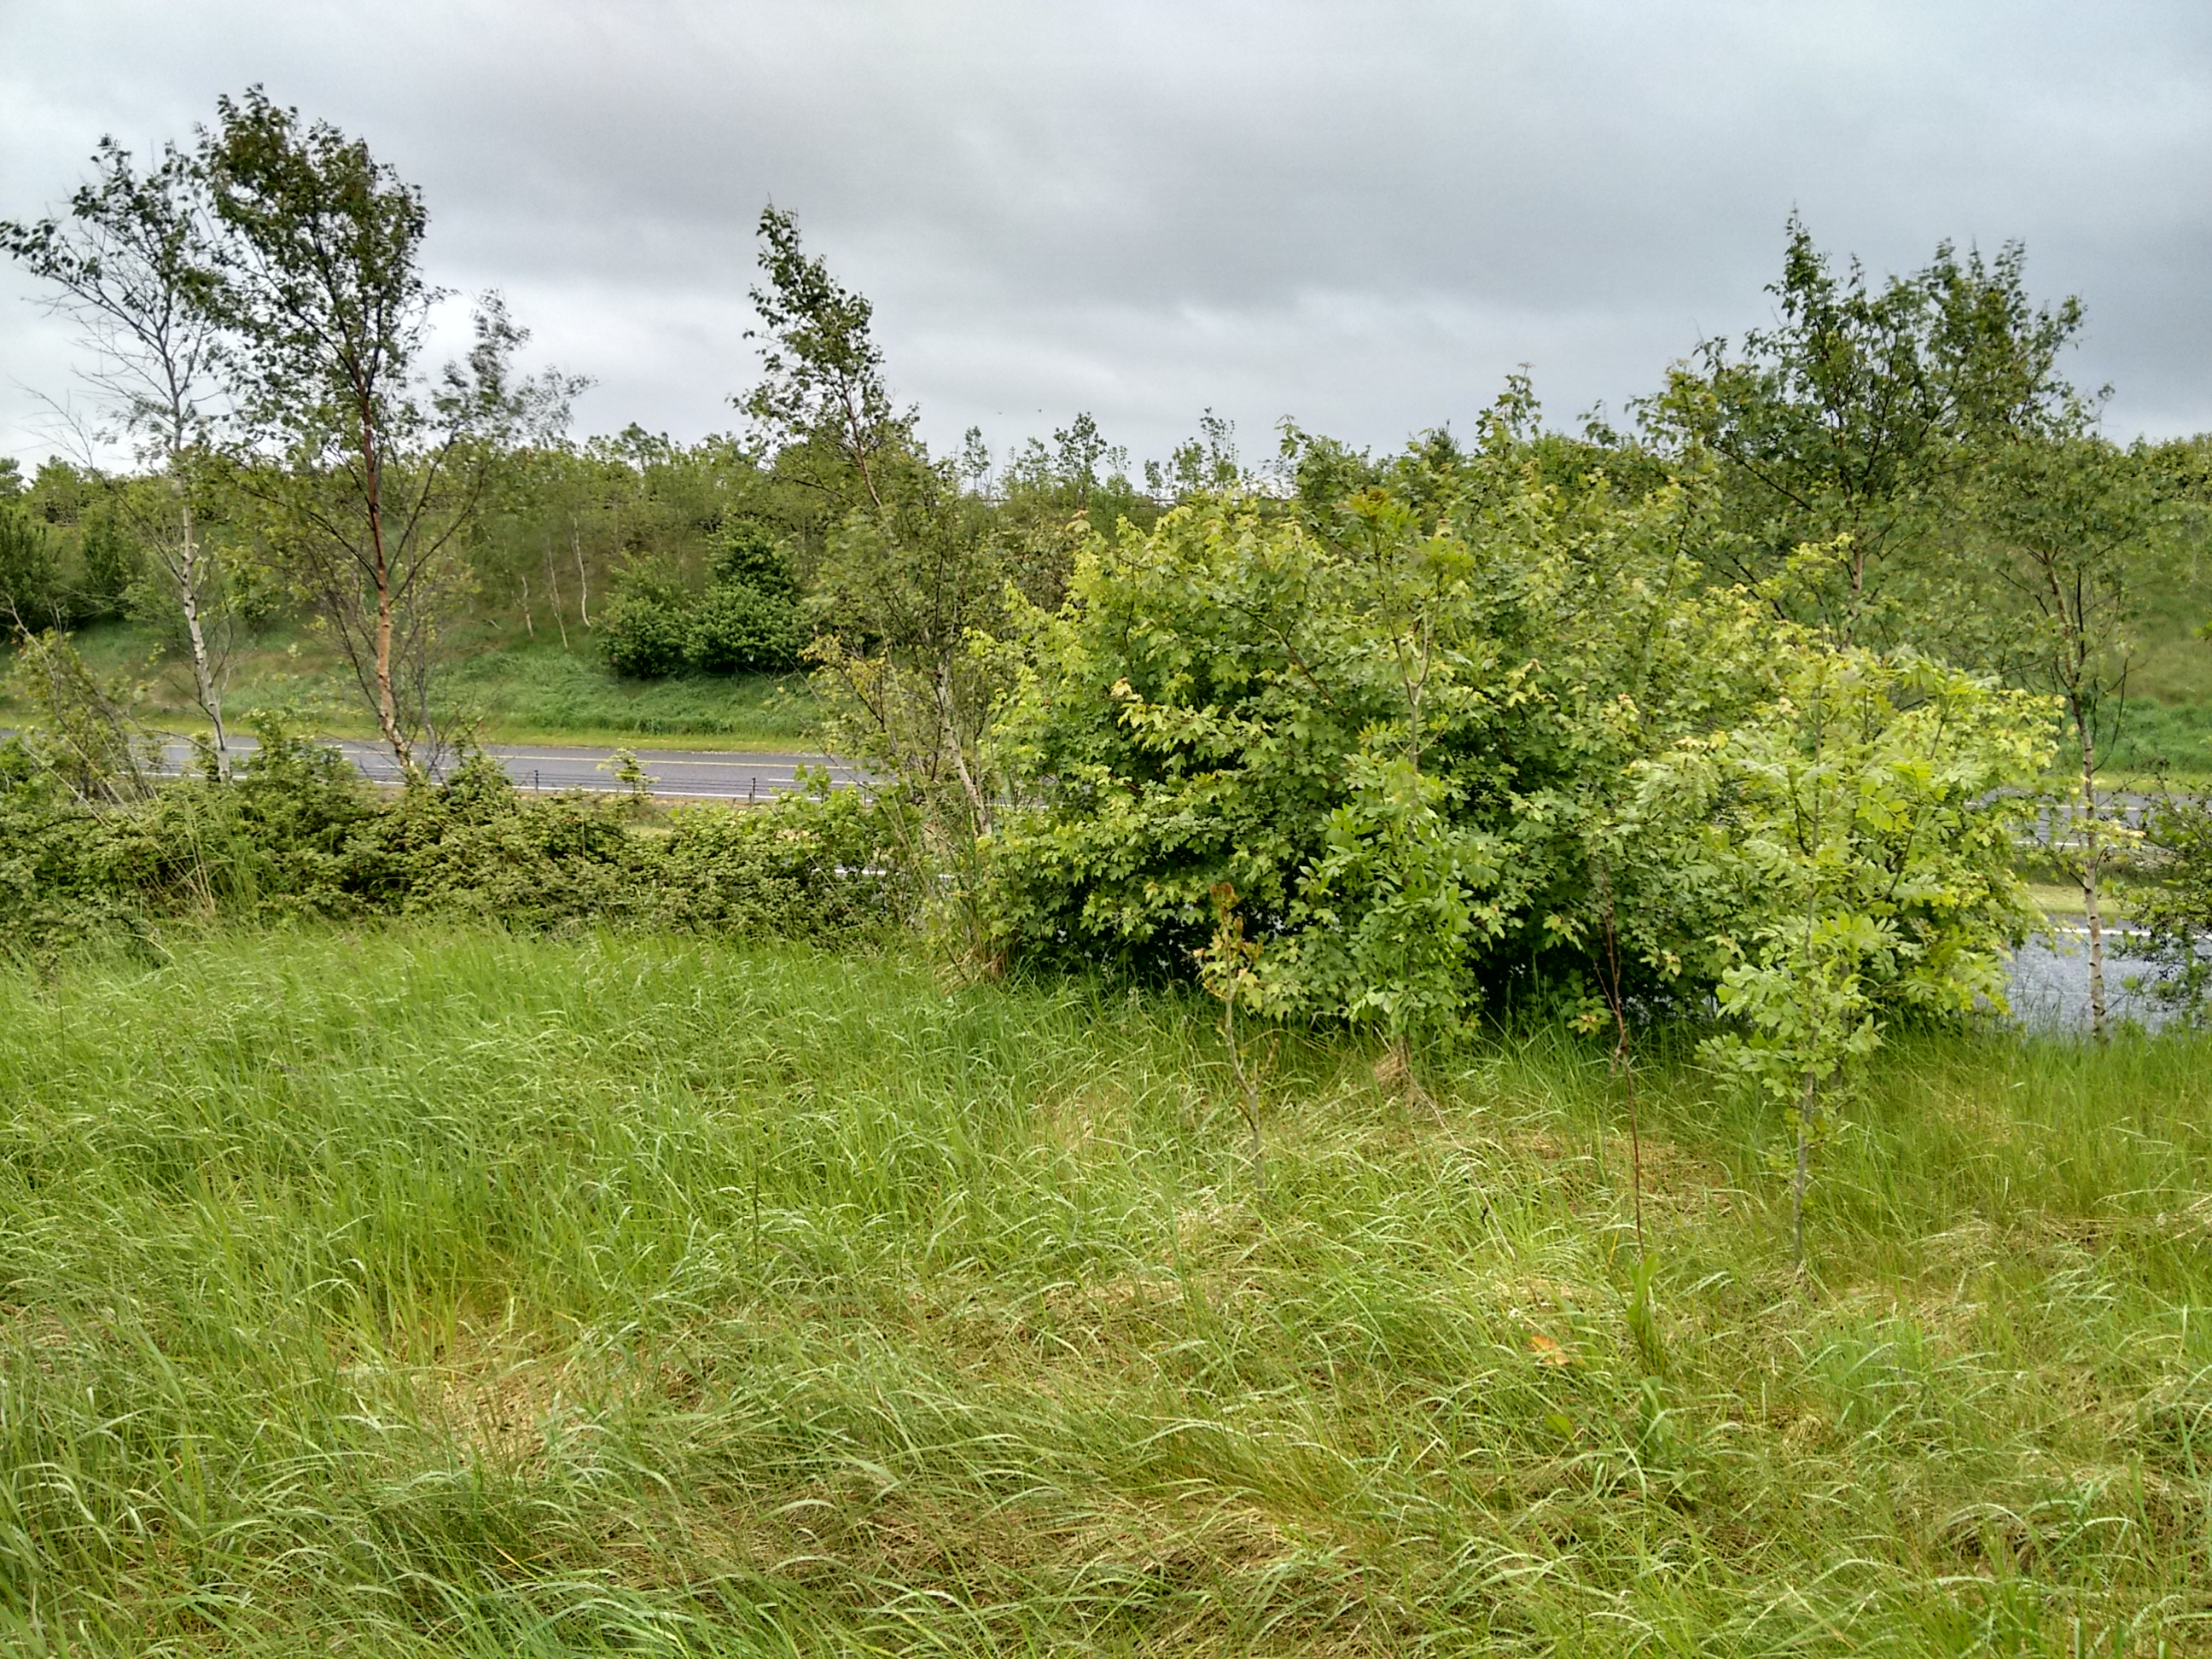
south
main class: Grassland
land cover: Grassland with sparse tree/shrub cover
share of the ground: > 75 %
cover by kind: herbaceous plants 85 %, shrubs 10 %, broadleaved forest trees 5 %
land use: Road transport
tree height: < 5 m
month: May
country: IE
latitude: 53.4268
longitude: -6.9507
